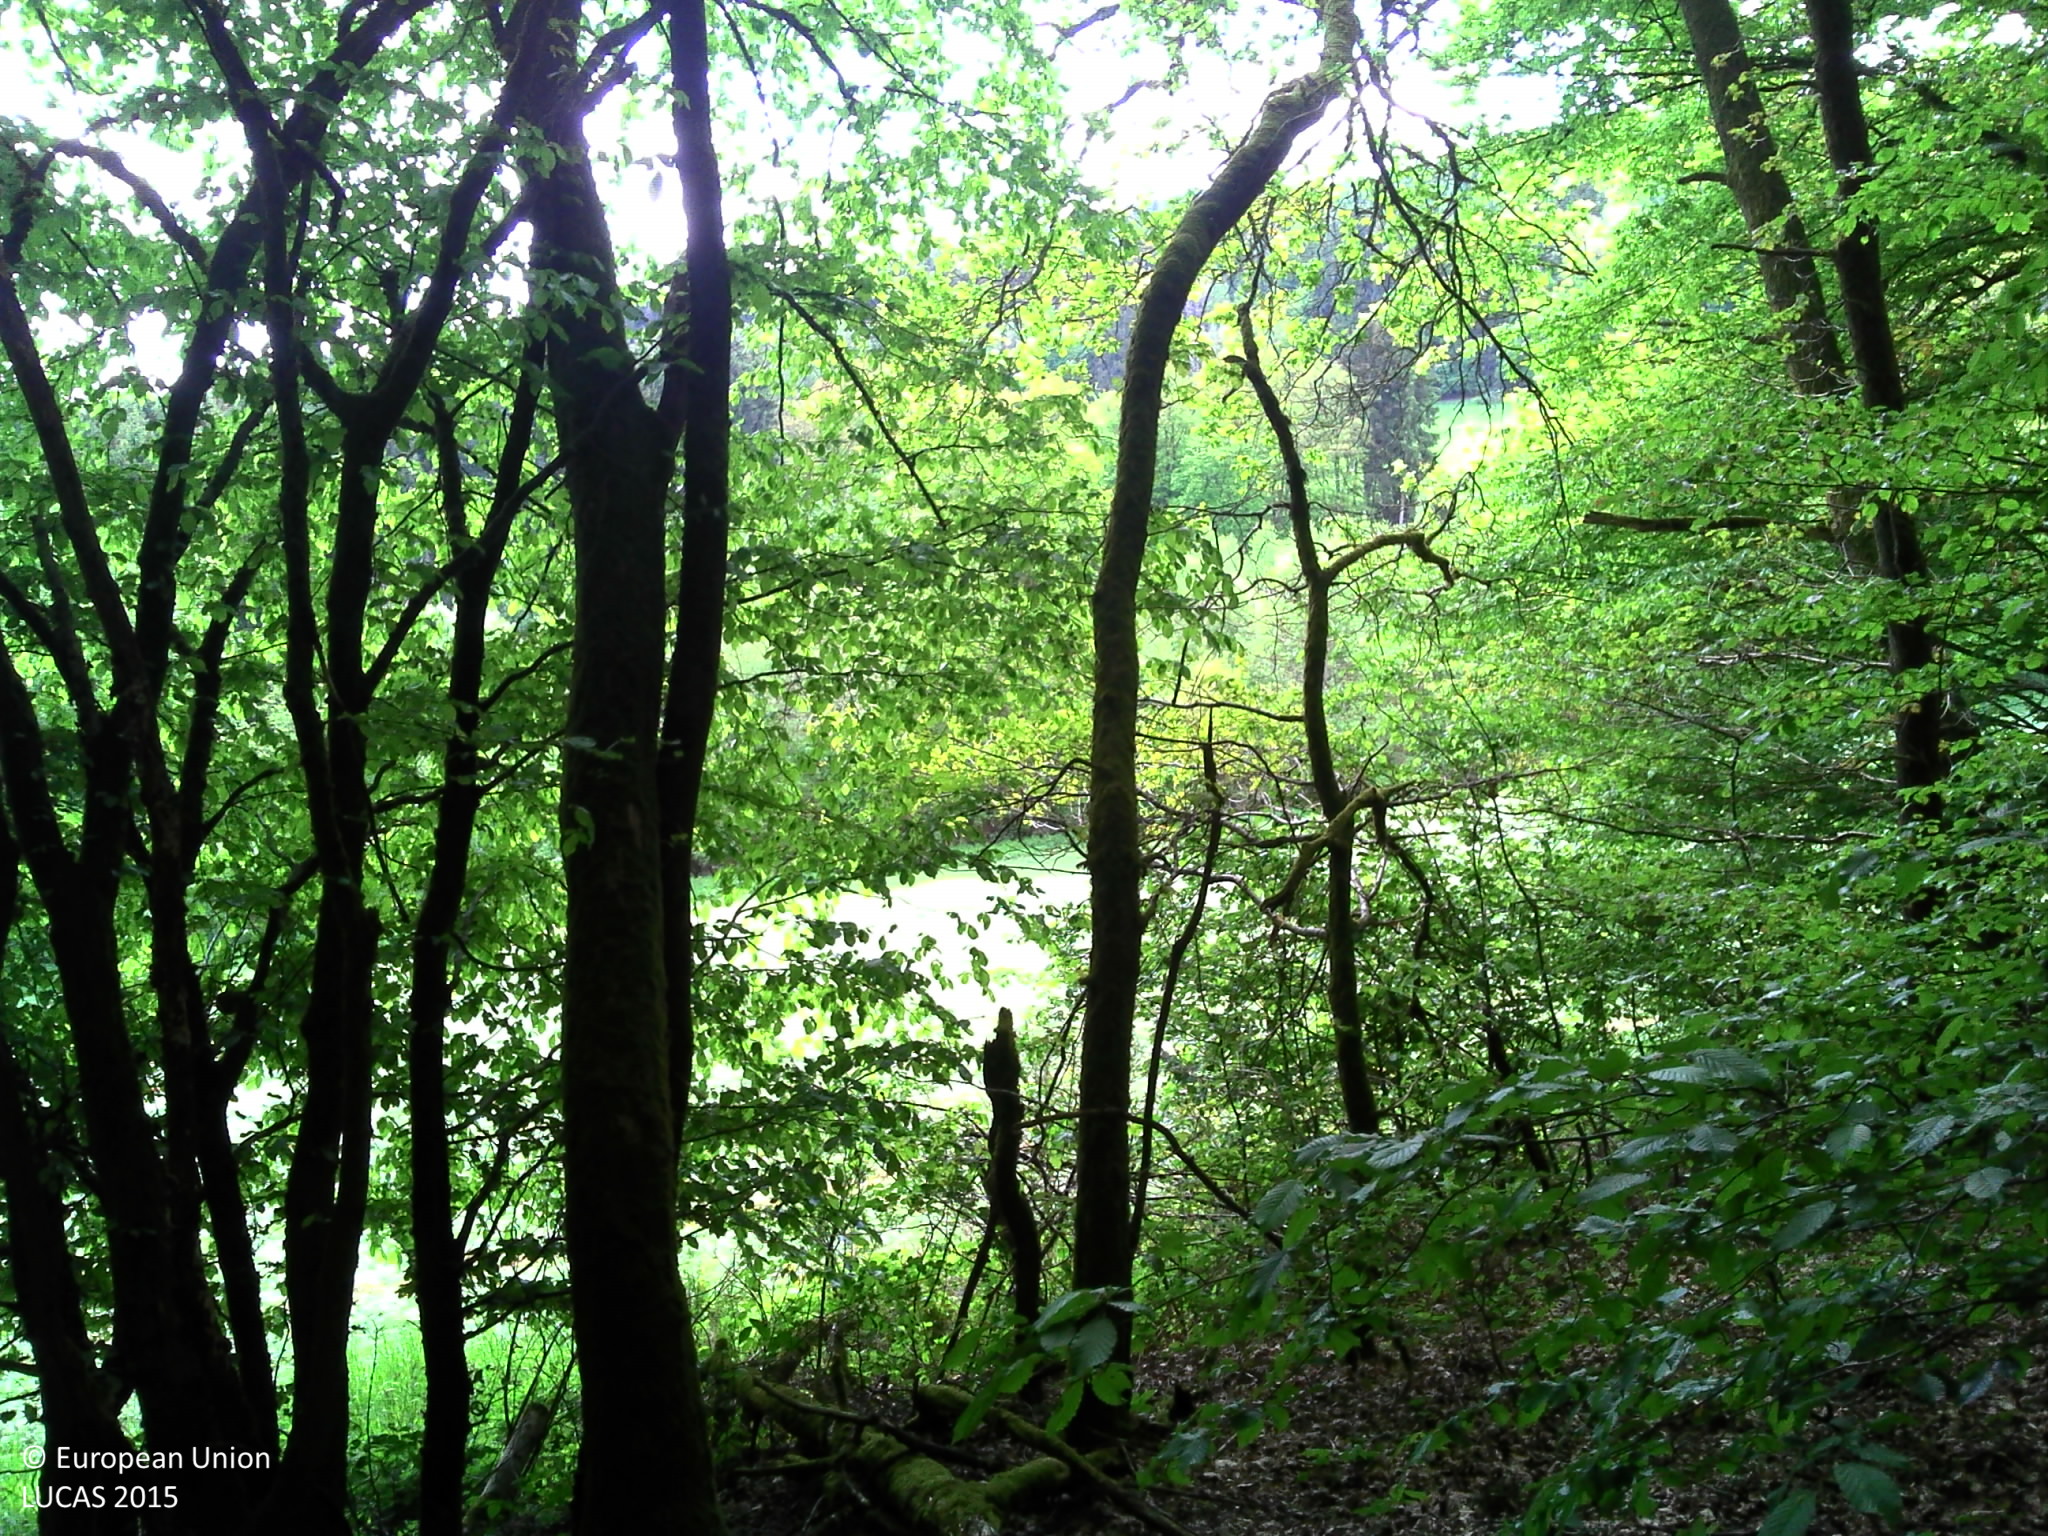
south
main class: Woodland
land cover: Broadleaved woodland
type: beech forest
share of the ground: > 75 %
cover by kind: broadleaved forest trees 90 %, lichens and mosses 10 %
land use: Forestry
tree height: > 5 m
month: May
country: LU
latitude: 49.9830
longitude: 5.8569
